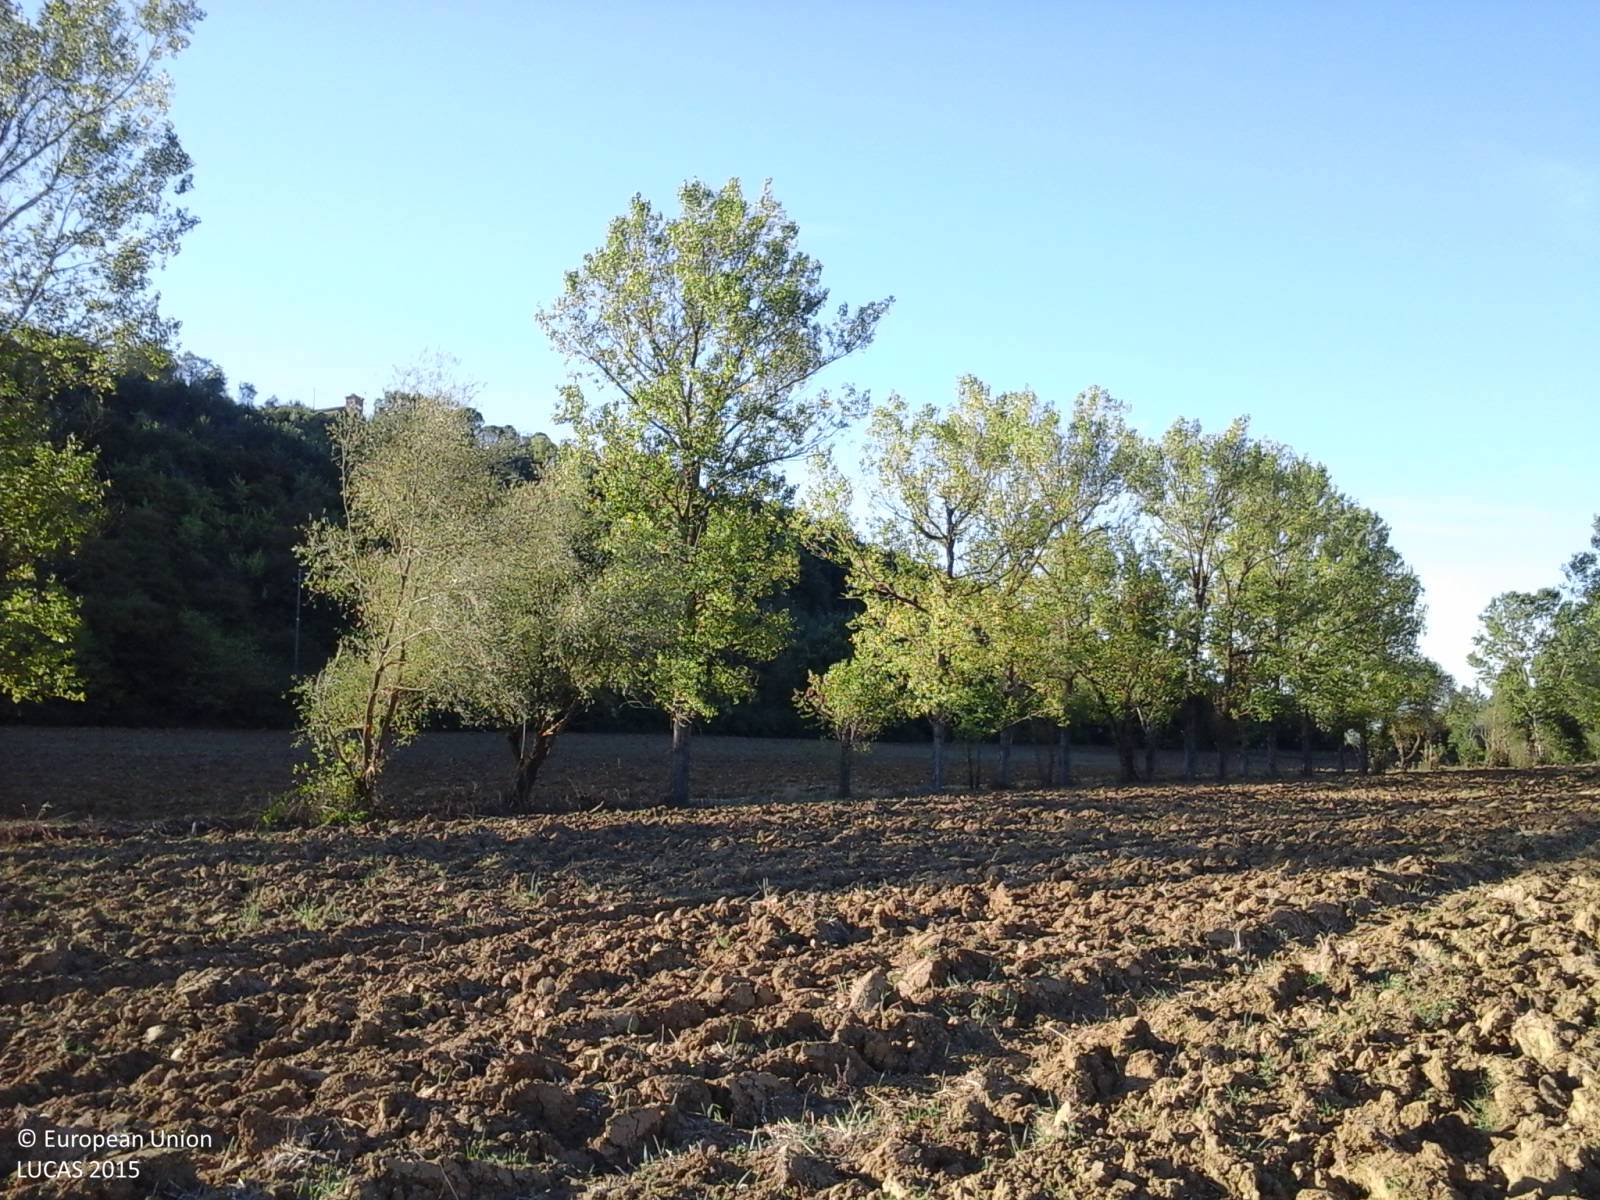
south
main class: Cropland
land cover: Common wheat
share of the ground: < 10 %
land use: Agriculture (excluding fallow land and kitchen gardens)
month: September
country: IT
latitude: 43.0600
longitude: 12.3628
